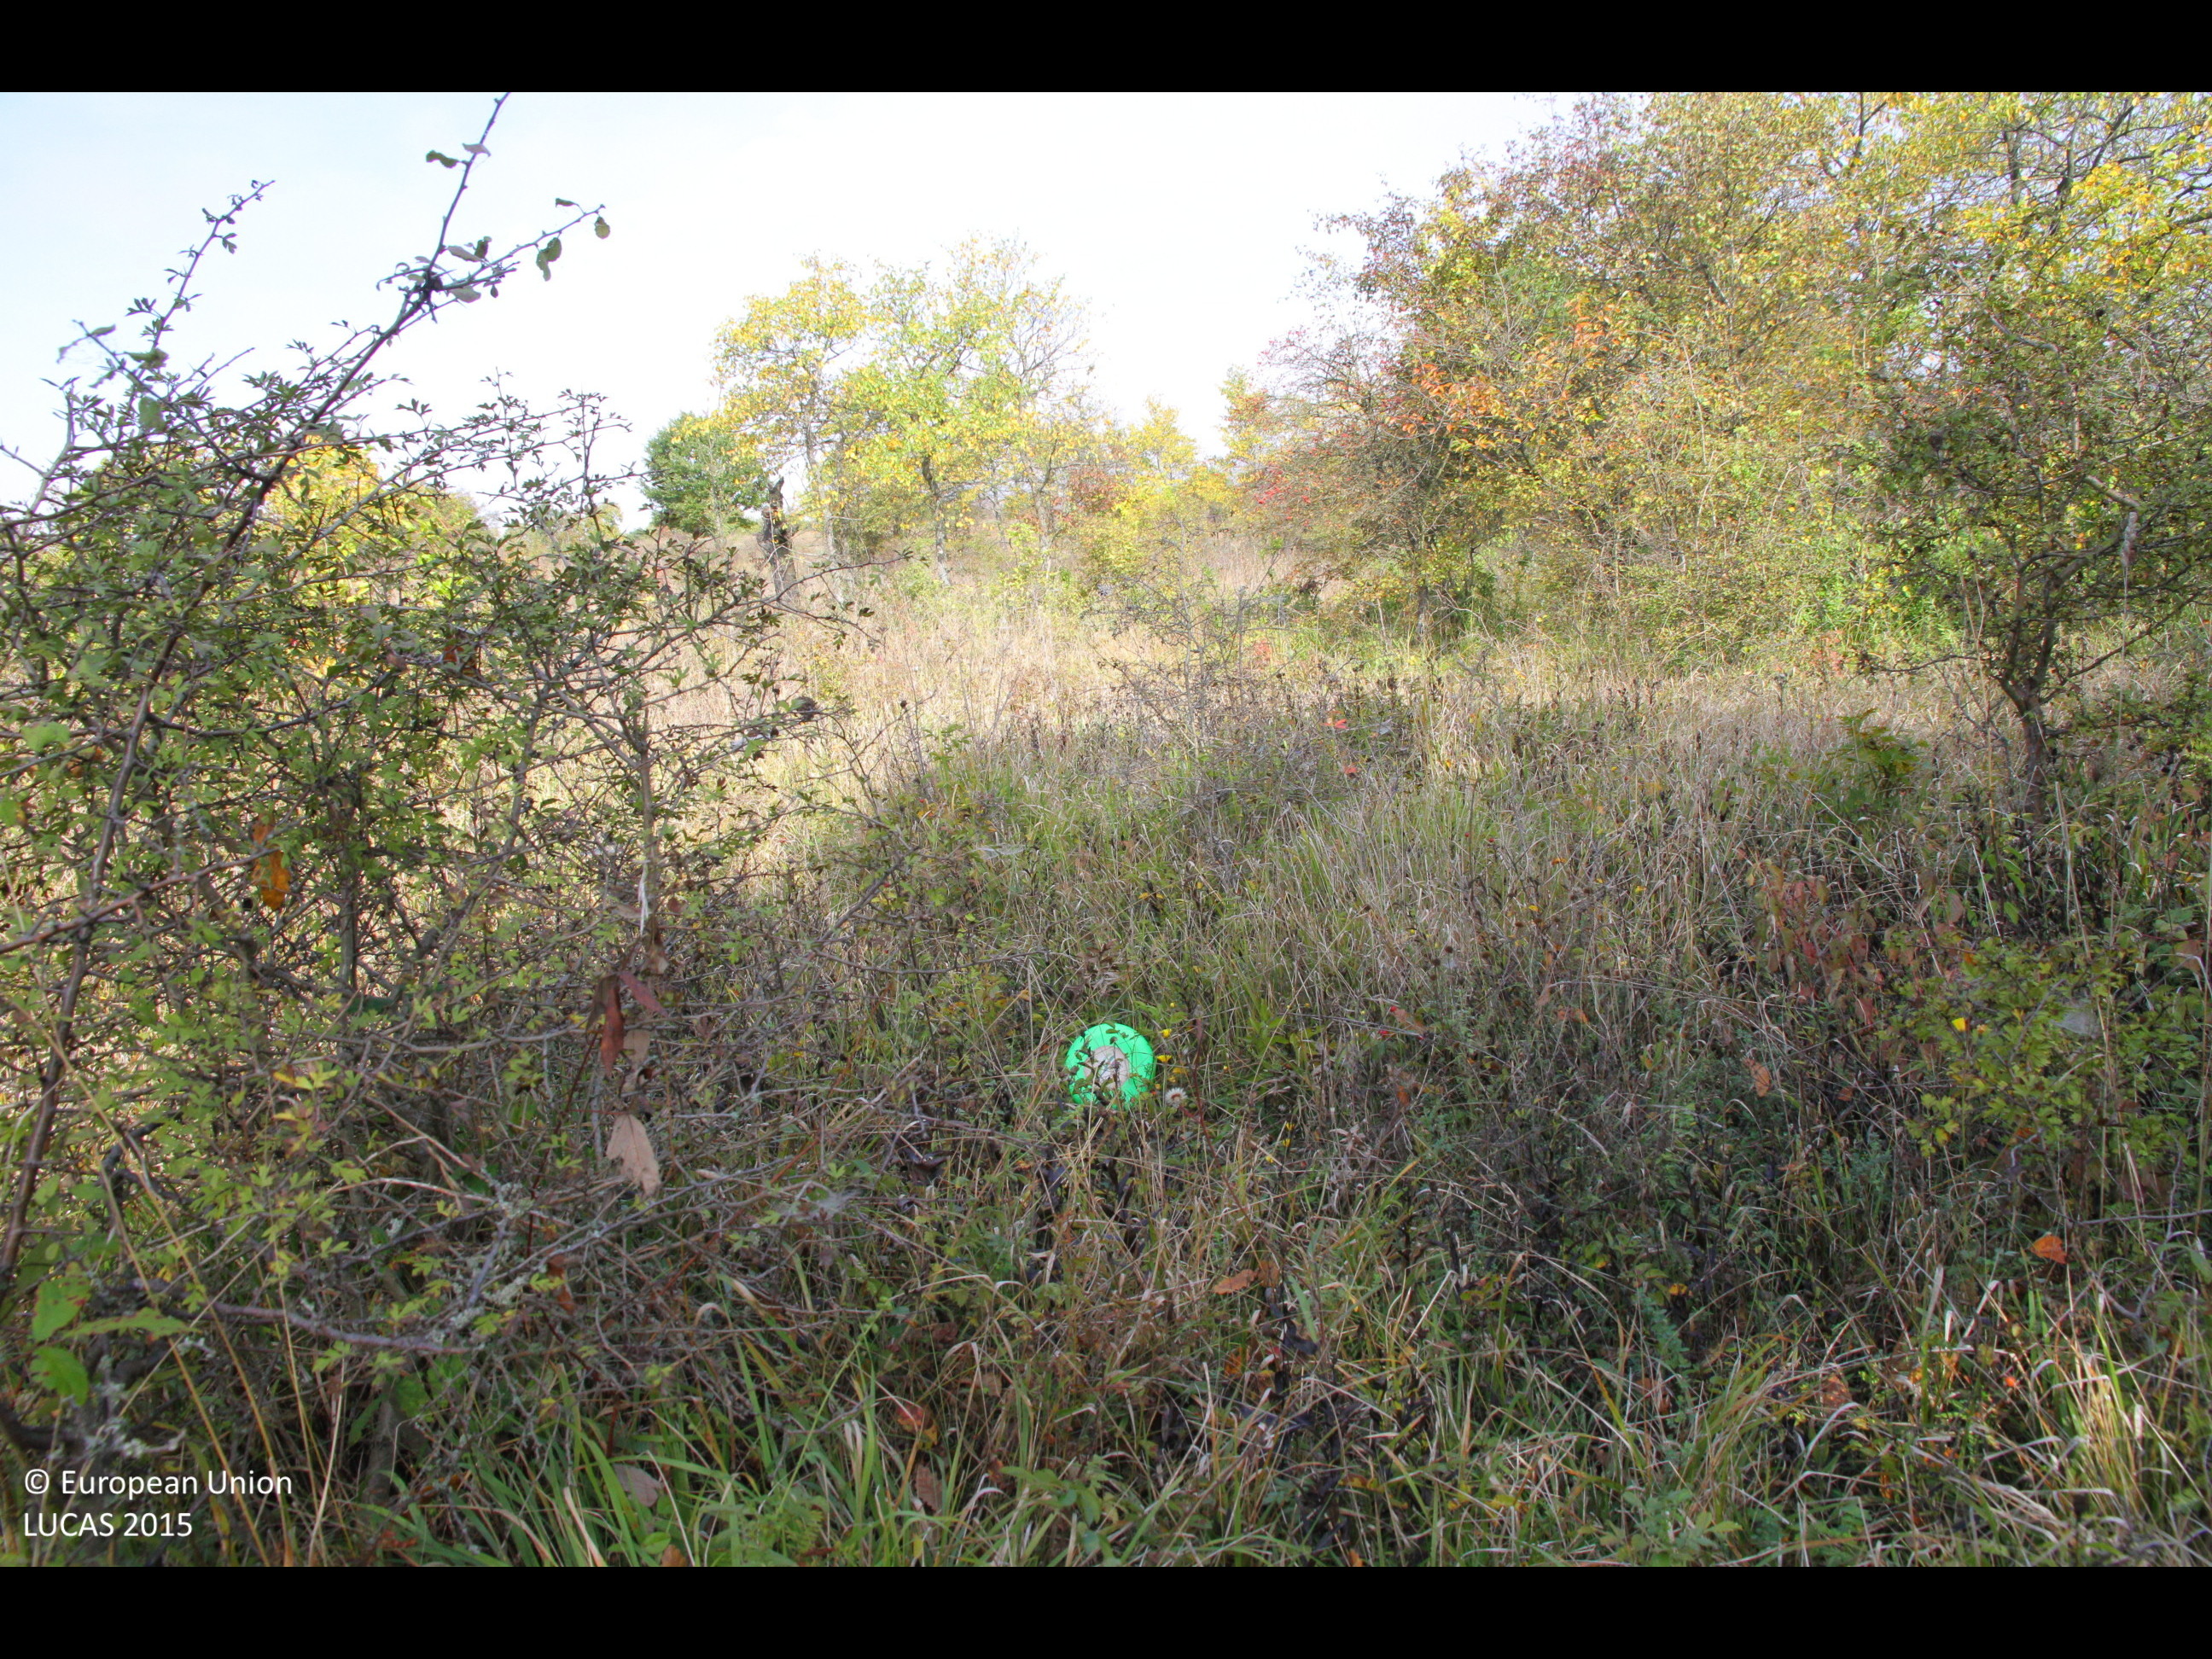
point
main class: Grassland
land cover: Grassland with sparse tree/shrub cover
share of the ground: > 75 %
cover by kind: herbaceous plants 85 %, shrubs 10 %, broadleaved forest trees 5 %
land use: Agriculture (excluding fallow land and kitchen gardens)
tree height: > 5 m
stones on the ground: < 10 %
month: October
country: BG
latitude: 43.0659
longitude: 27.0976
